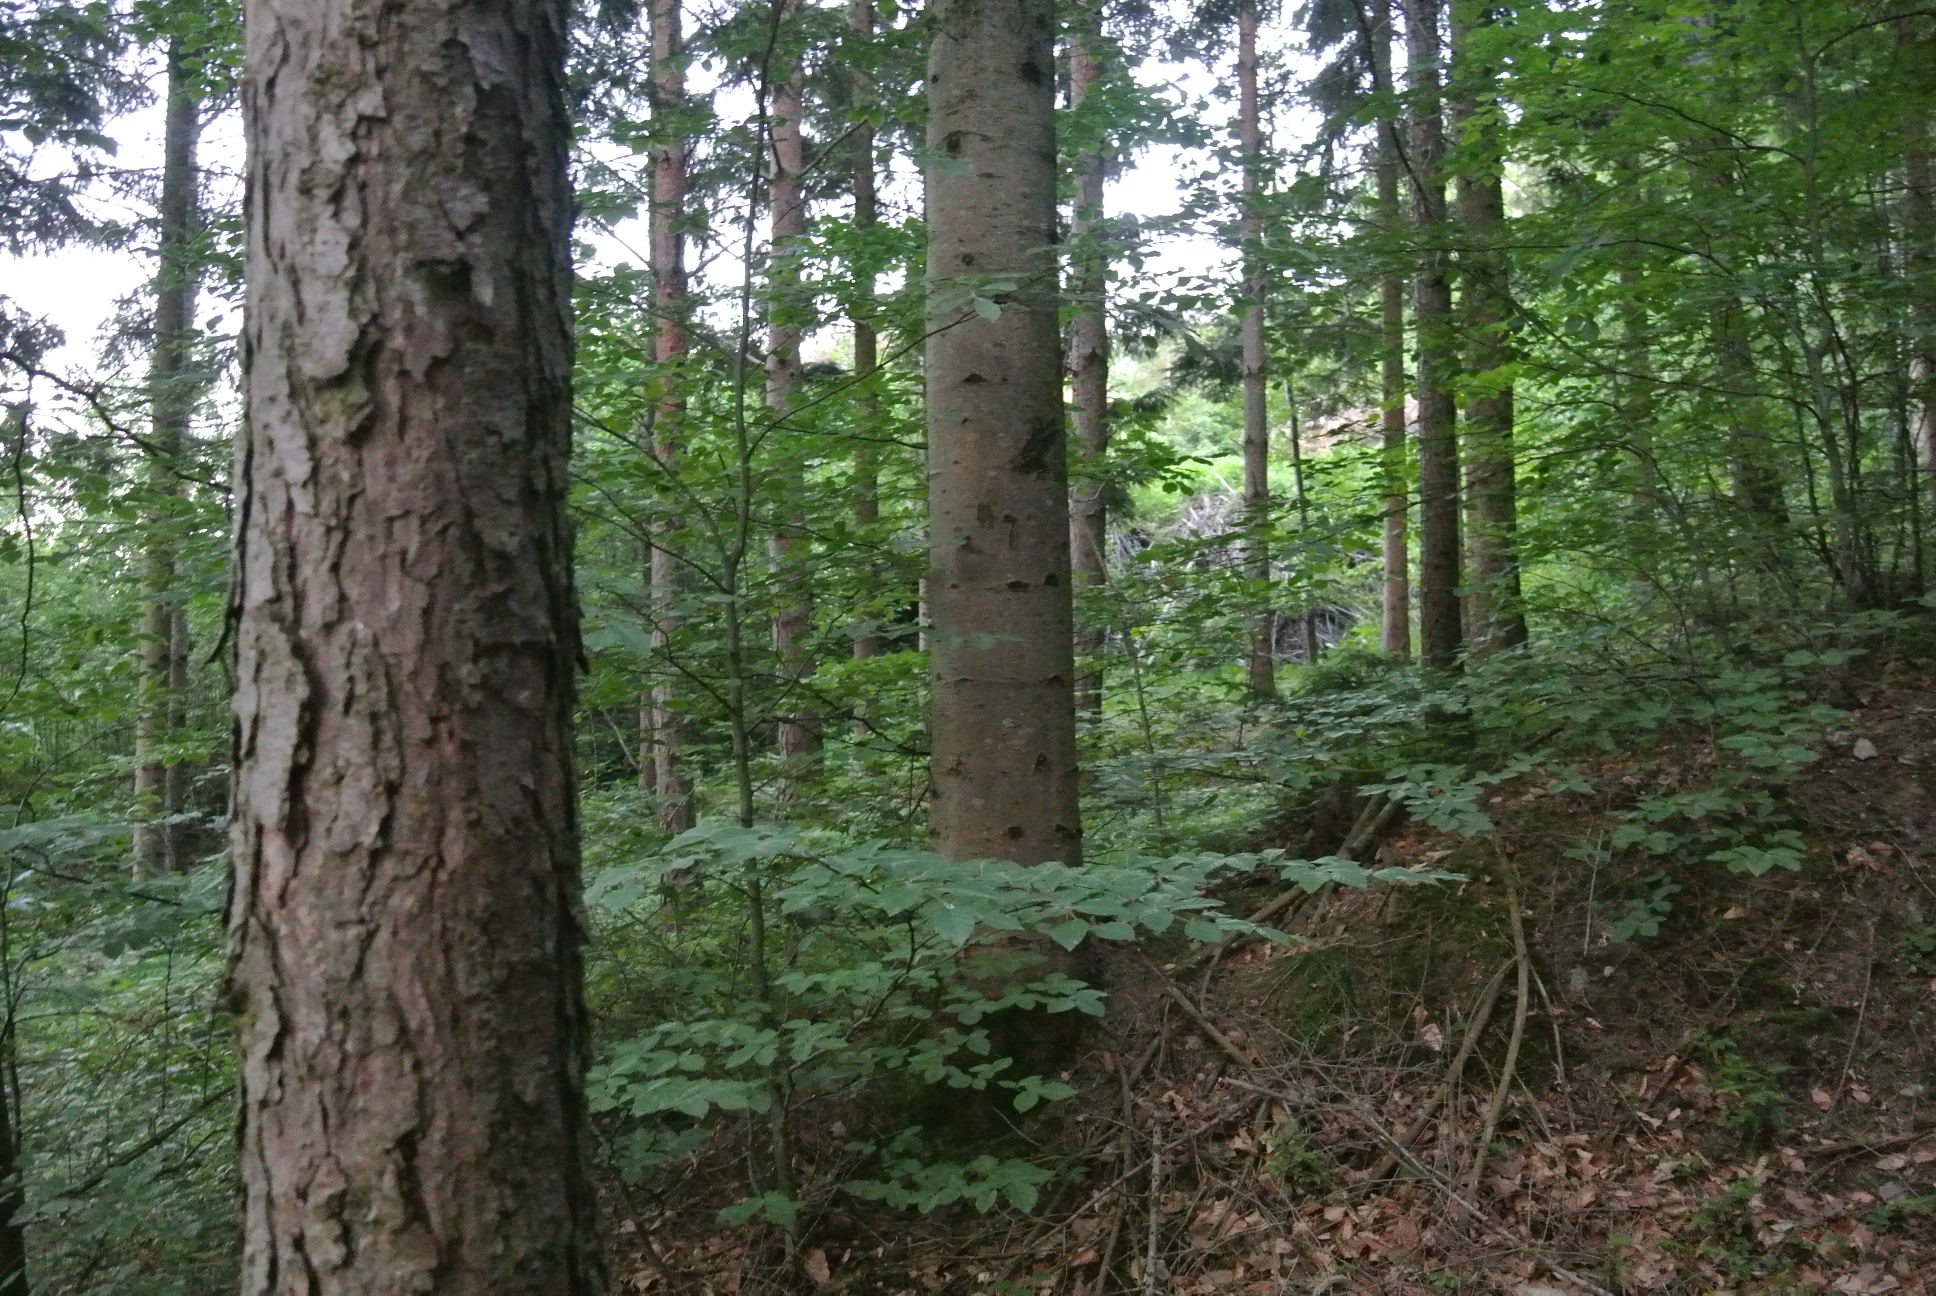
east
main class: Woodland
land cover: Other mixed woodland
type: mesophytic deciduous forest
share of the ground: > 75 %
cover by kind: coniferous forest trees 70 %, broadleaved forest trees 30 %
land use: Forestry
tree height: > 5 m
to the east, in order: Other mixed woodland; Spruce dominated coniferous woodland; Shrubland with sparse tree cover; Other bare soil; Broadleaved woodland; Grassland with sparse tree/shrub cover; Tracks; Grassland with sparse tree/shrub cover; Artificial constructions in urban areas
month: May
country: AT
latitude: 47.6907
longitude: 15.8245
